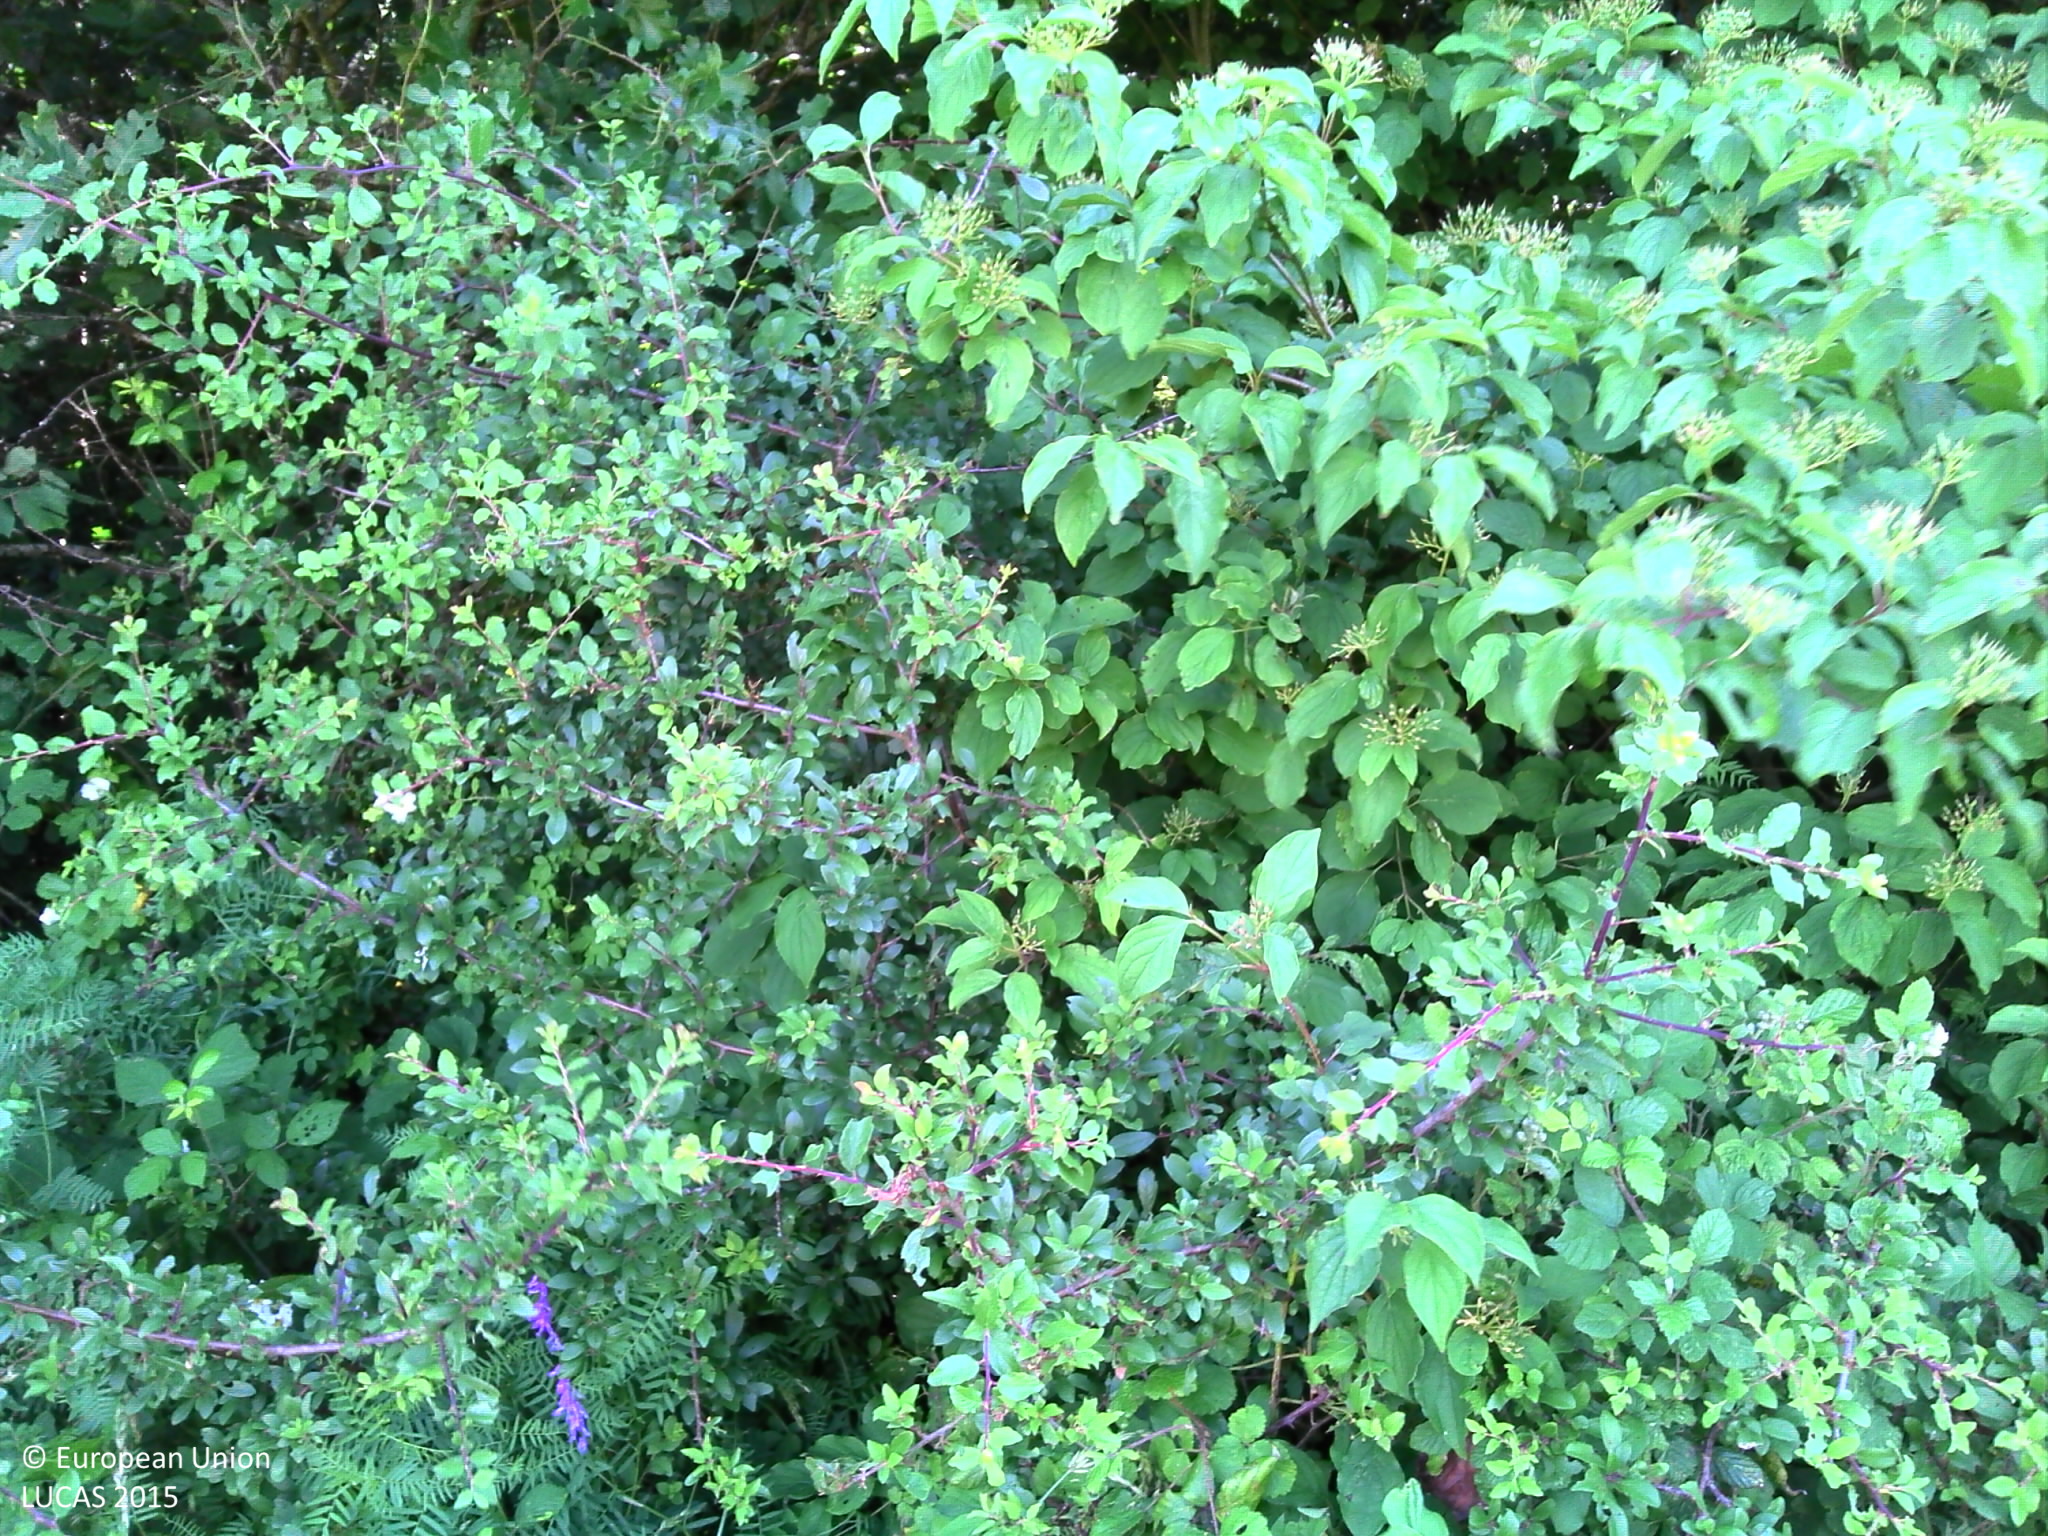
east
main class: Woodland
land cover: Broadleaved woodland
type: acidophilous oak and oak-birch forest
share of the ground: > 75 %
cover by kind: broadleaved forest trees 95 %, shrubs 5 %
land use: Forestry
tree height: > 5 m
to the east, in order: Broadleaved woodland; Ditches and canals; Broadleaved woodland
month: June
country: FR
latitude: 47.0750
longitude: 2.6585
